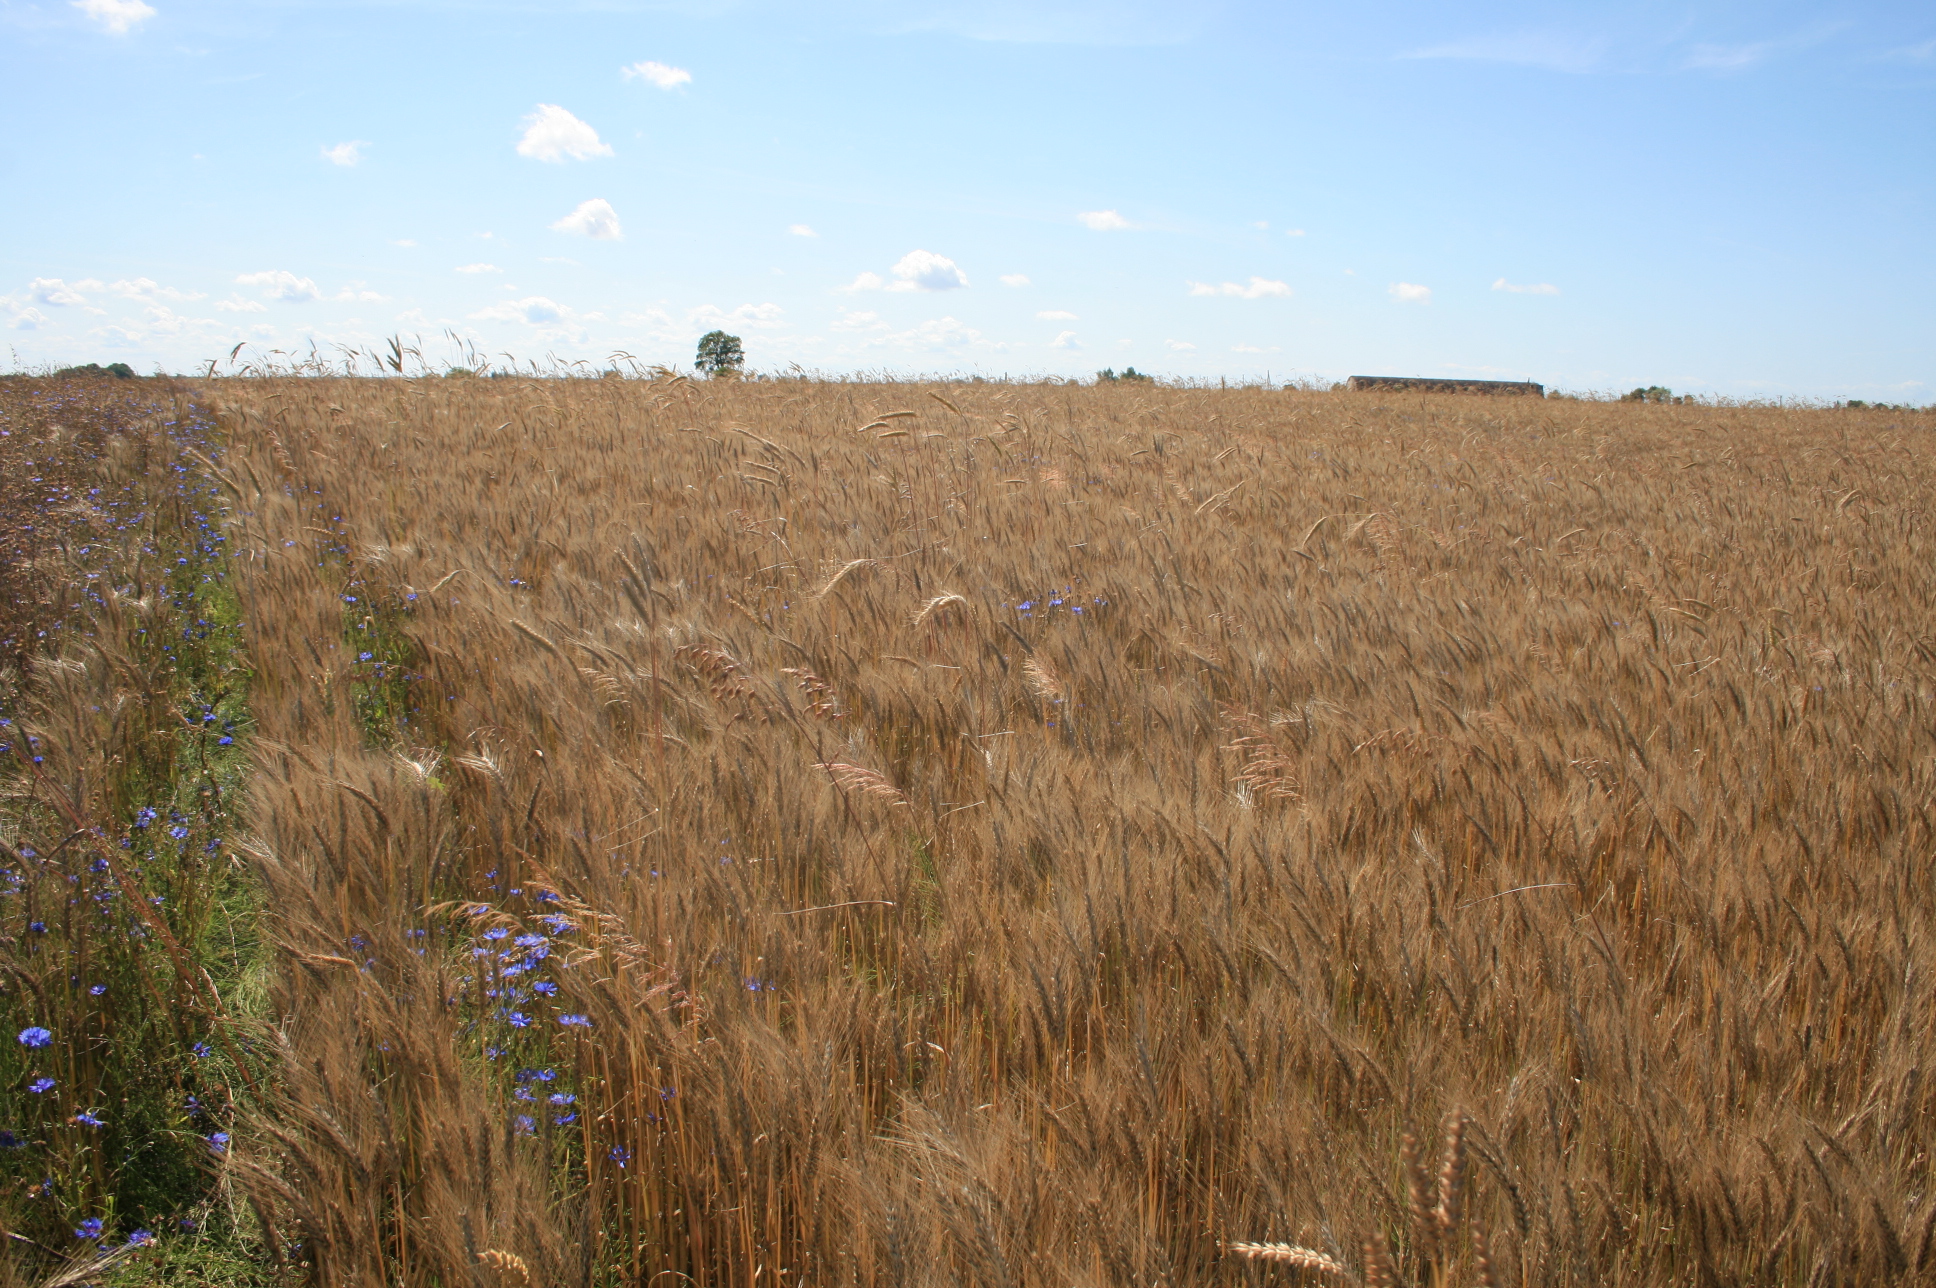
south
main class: Cropland
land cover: Triticale
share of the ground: > 75 %
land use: Agriculture (excluding fallow land and kitchen gardens)
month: July
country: LT
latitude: 55.4669
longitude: 21.3213
